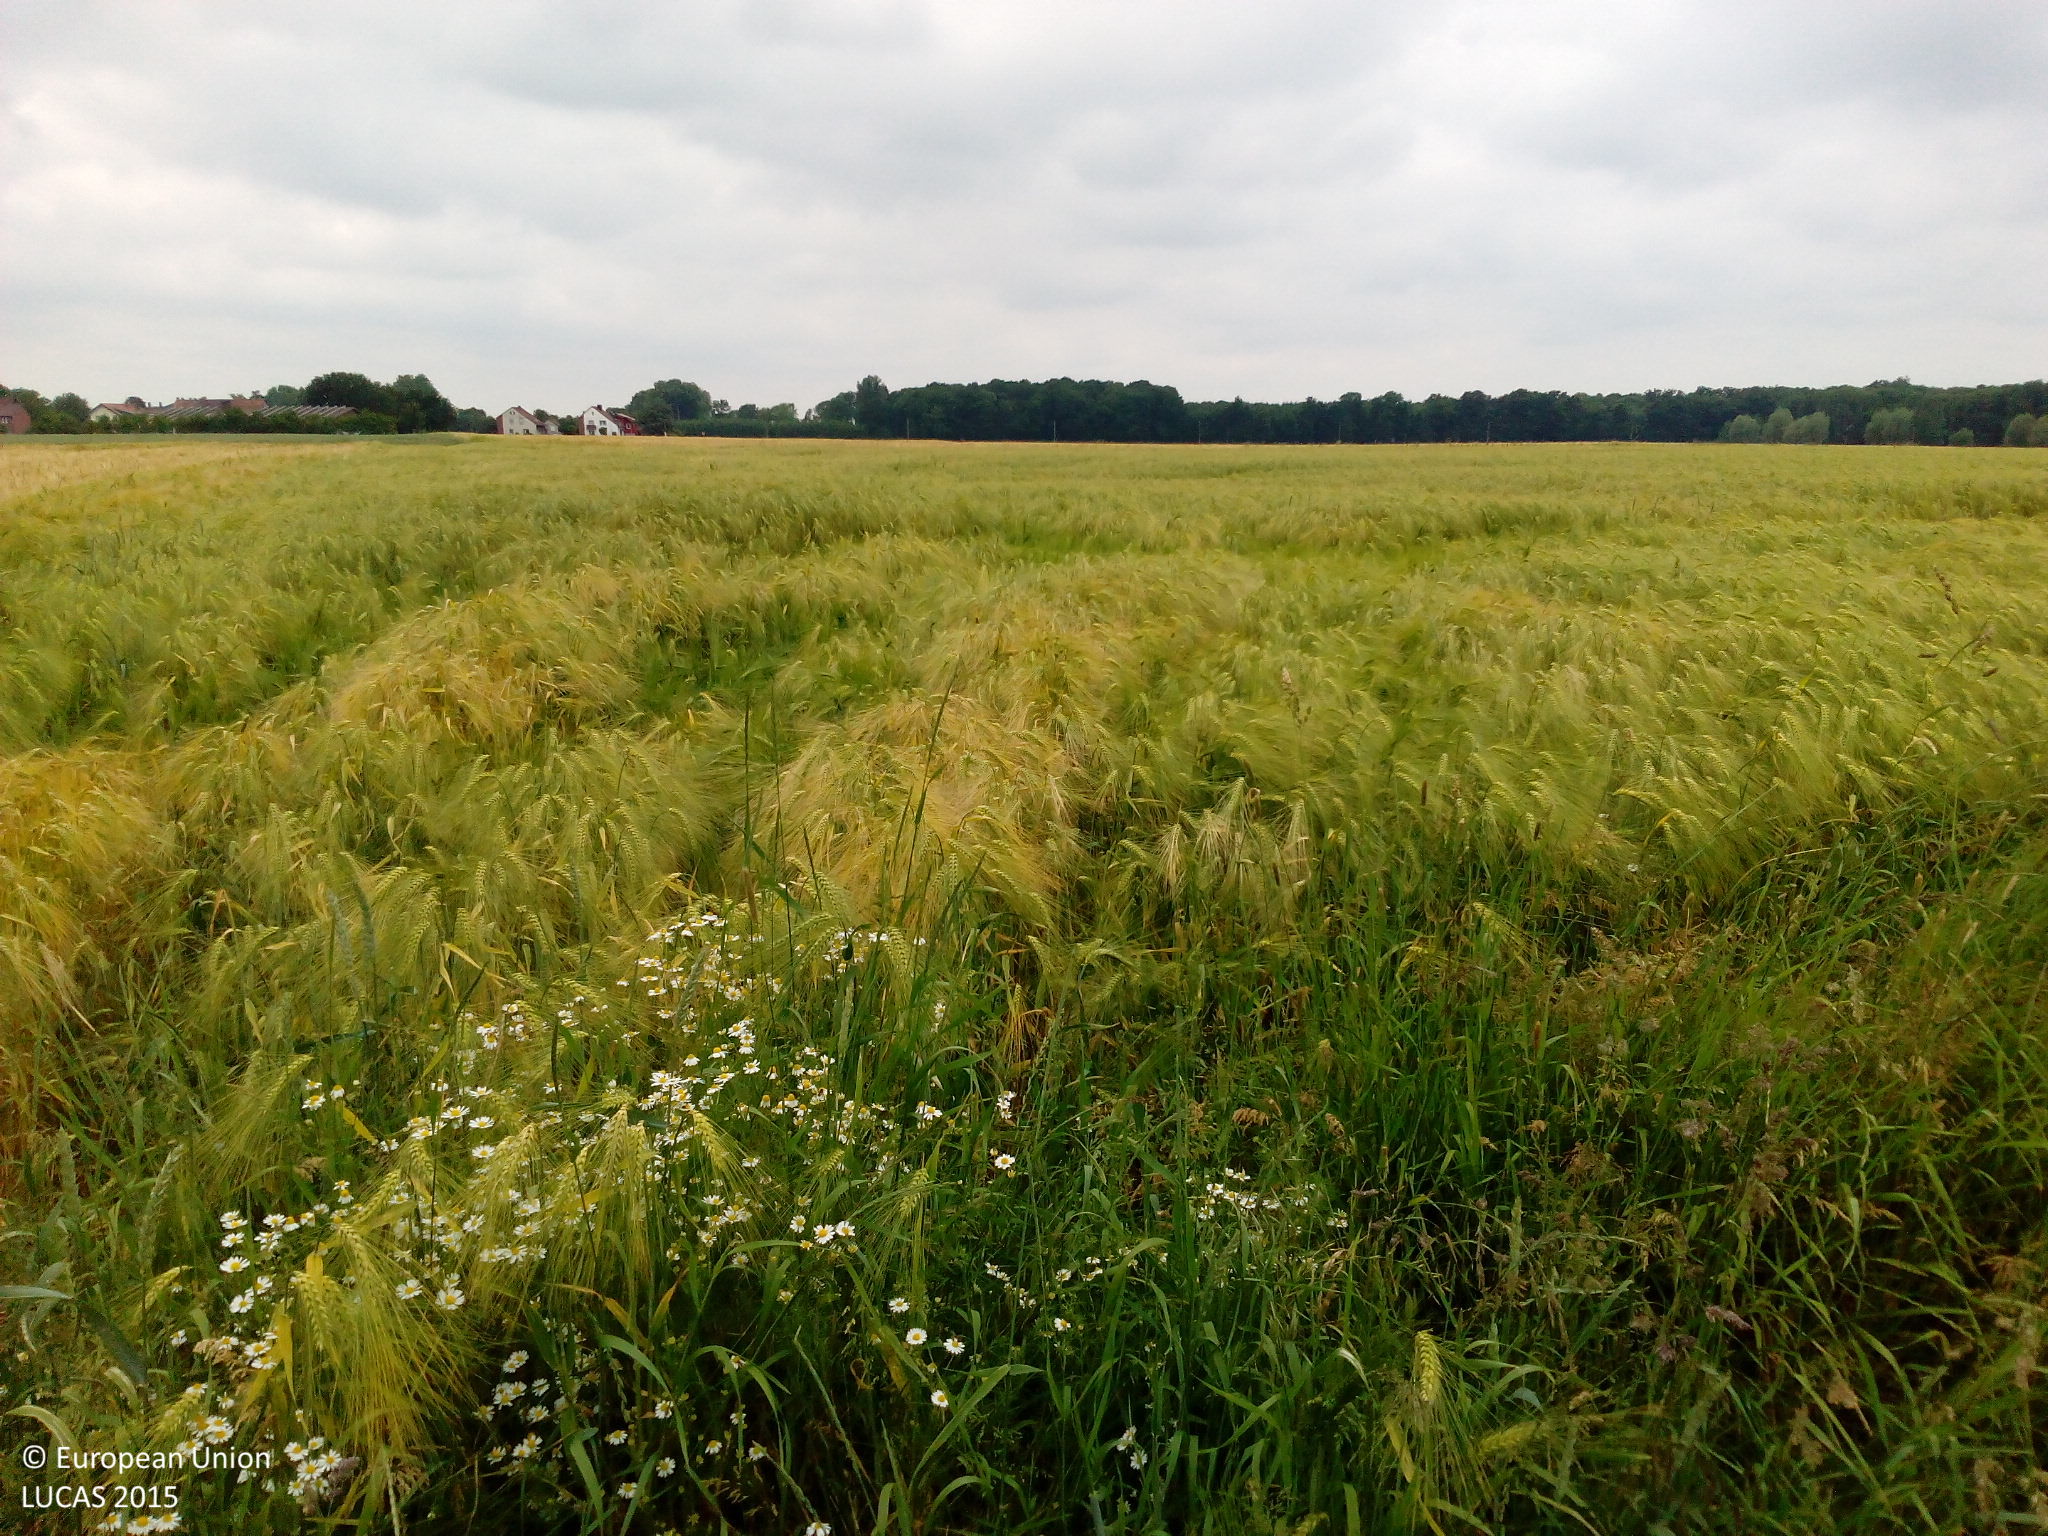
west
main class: Grassland
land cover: Grassland without tree/shrub cover
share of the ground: > 75 %
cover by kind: herbaceous plants 100 %
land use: Agriculture (excluding fallow land and kitchen gardens)
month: June
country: DE
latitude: 51.6479
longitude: 8.4251
